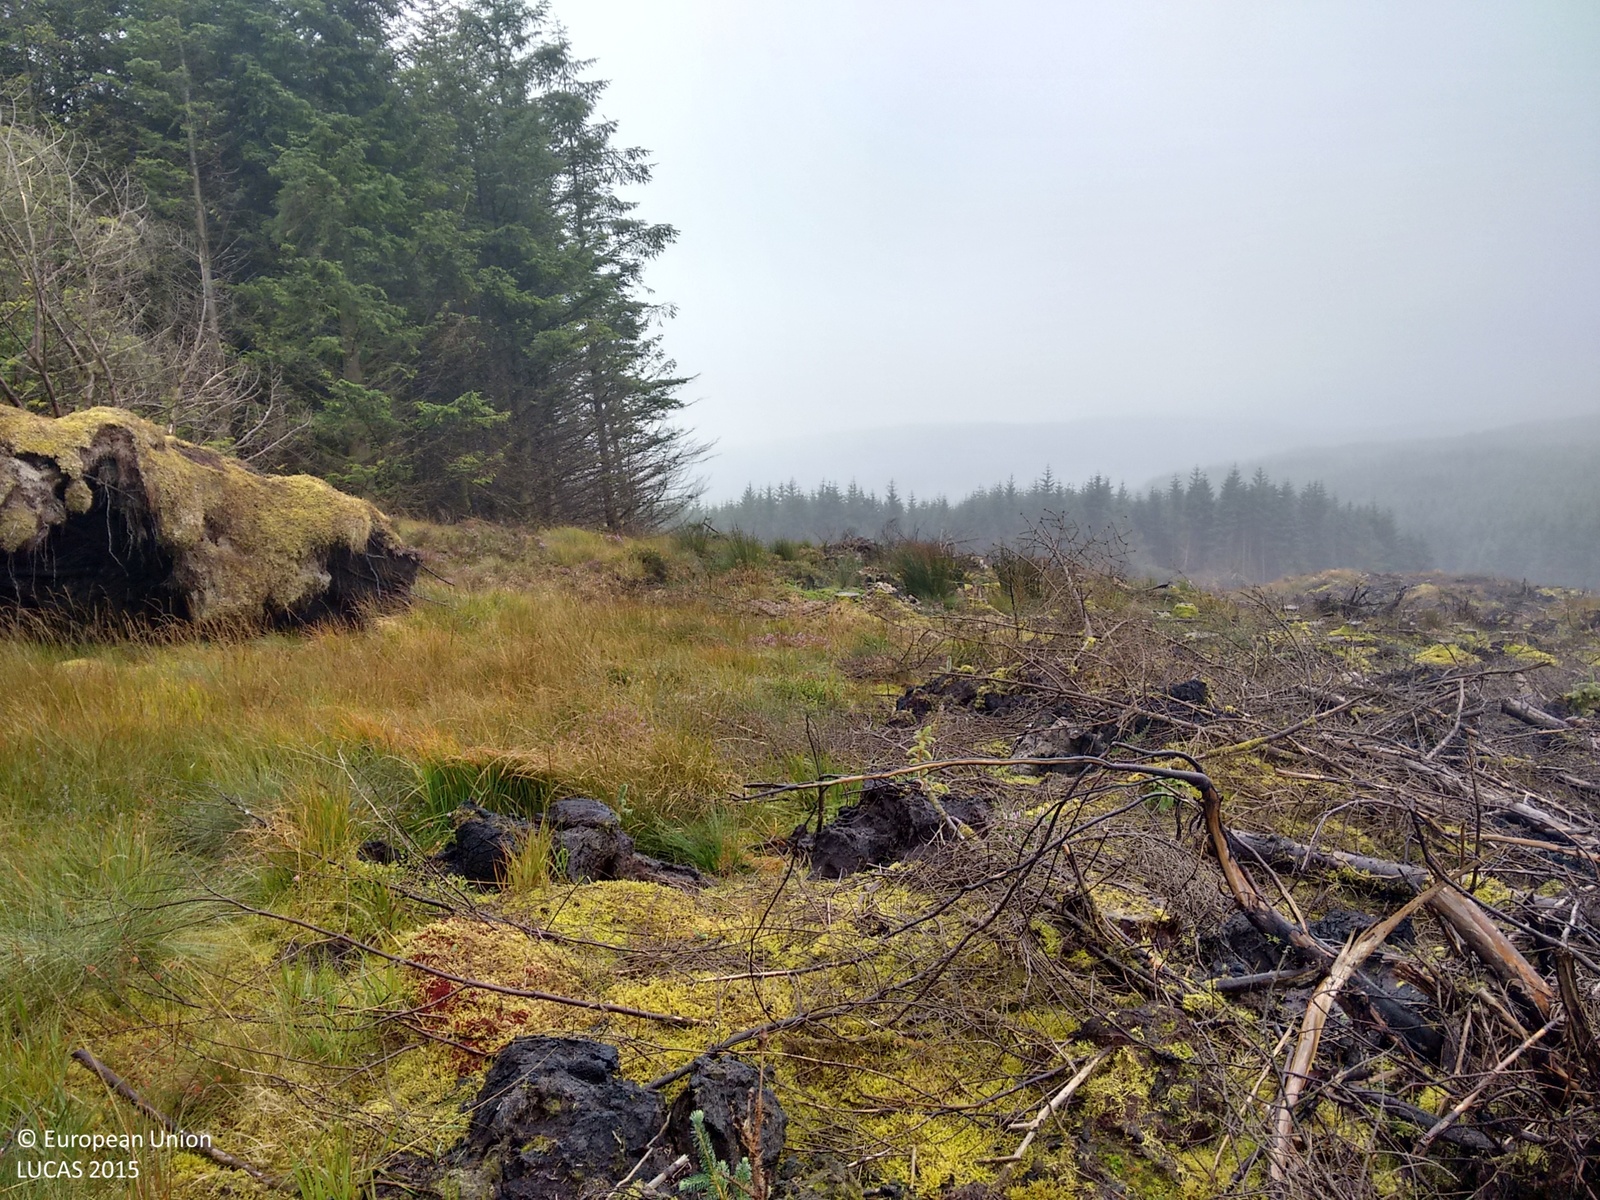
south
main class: Woodland
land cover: Spruce dominated coniferous woodland
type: exotic forest
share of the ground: > 75 %
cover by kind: coniferous forest trees 100 %
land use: Forestry
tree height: > 5 m
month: September
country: GB
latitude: 55.6350
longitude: -5.5496
